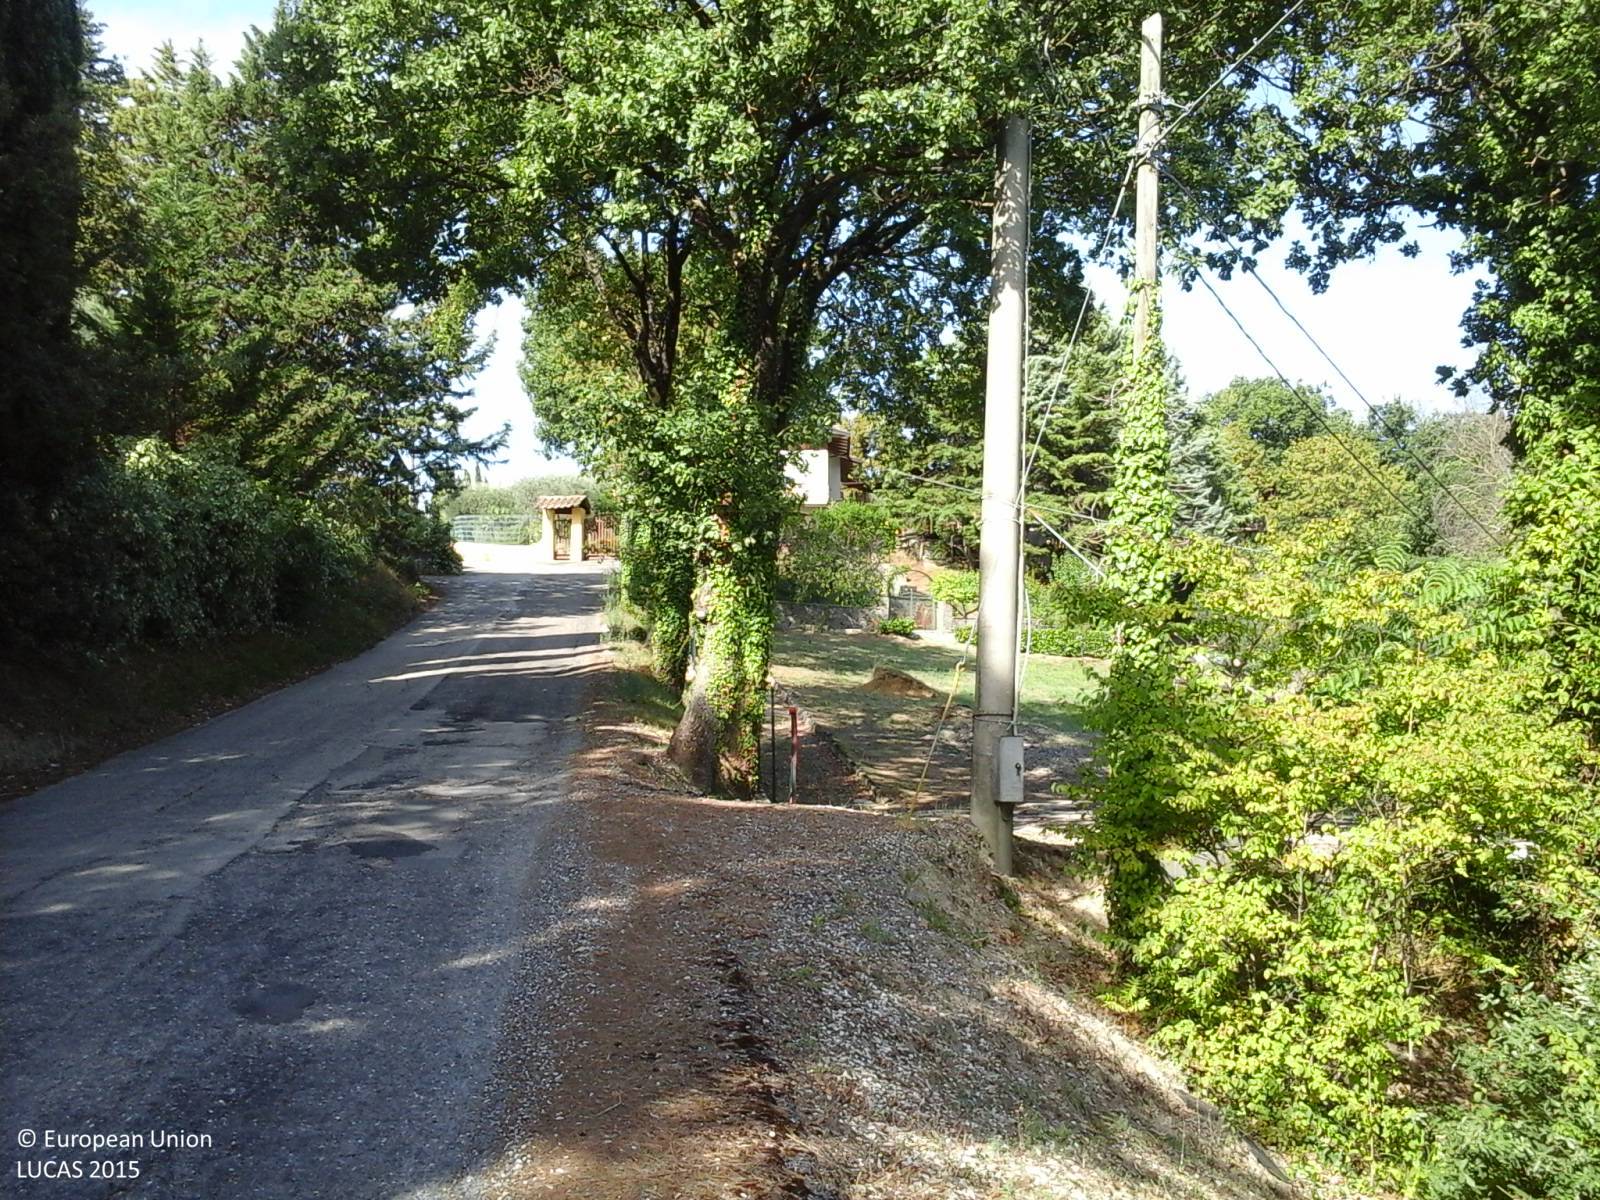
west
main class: Woodland
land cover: Other mixed woodland
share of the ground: > 75 %
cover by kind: coniferous forest trees 60 %, broadleaved forest trees 40 %
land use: Forestry
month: September
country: IT
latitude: 43.1311
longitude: 12.4147
